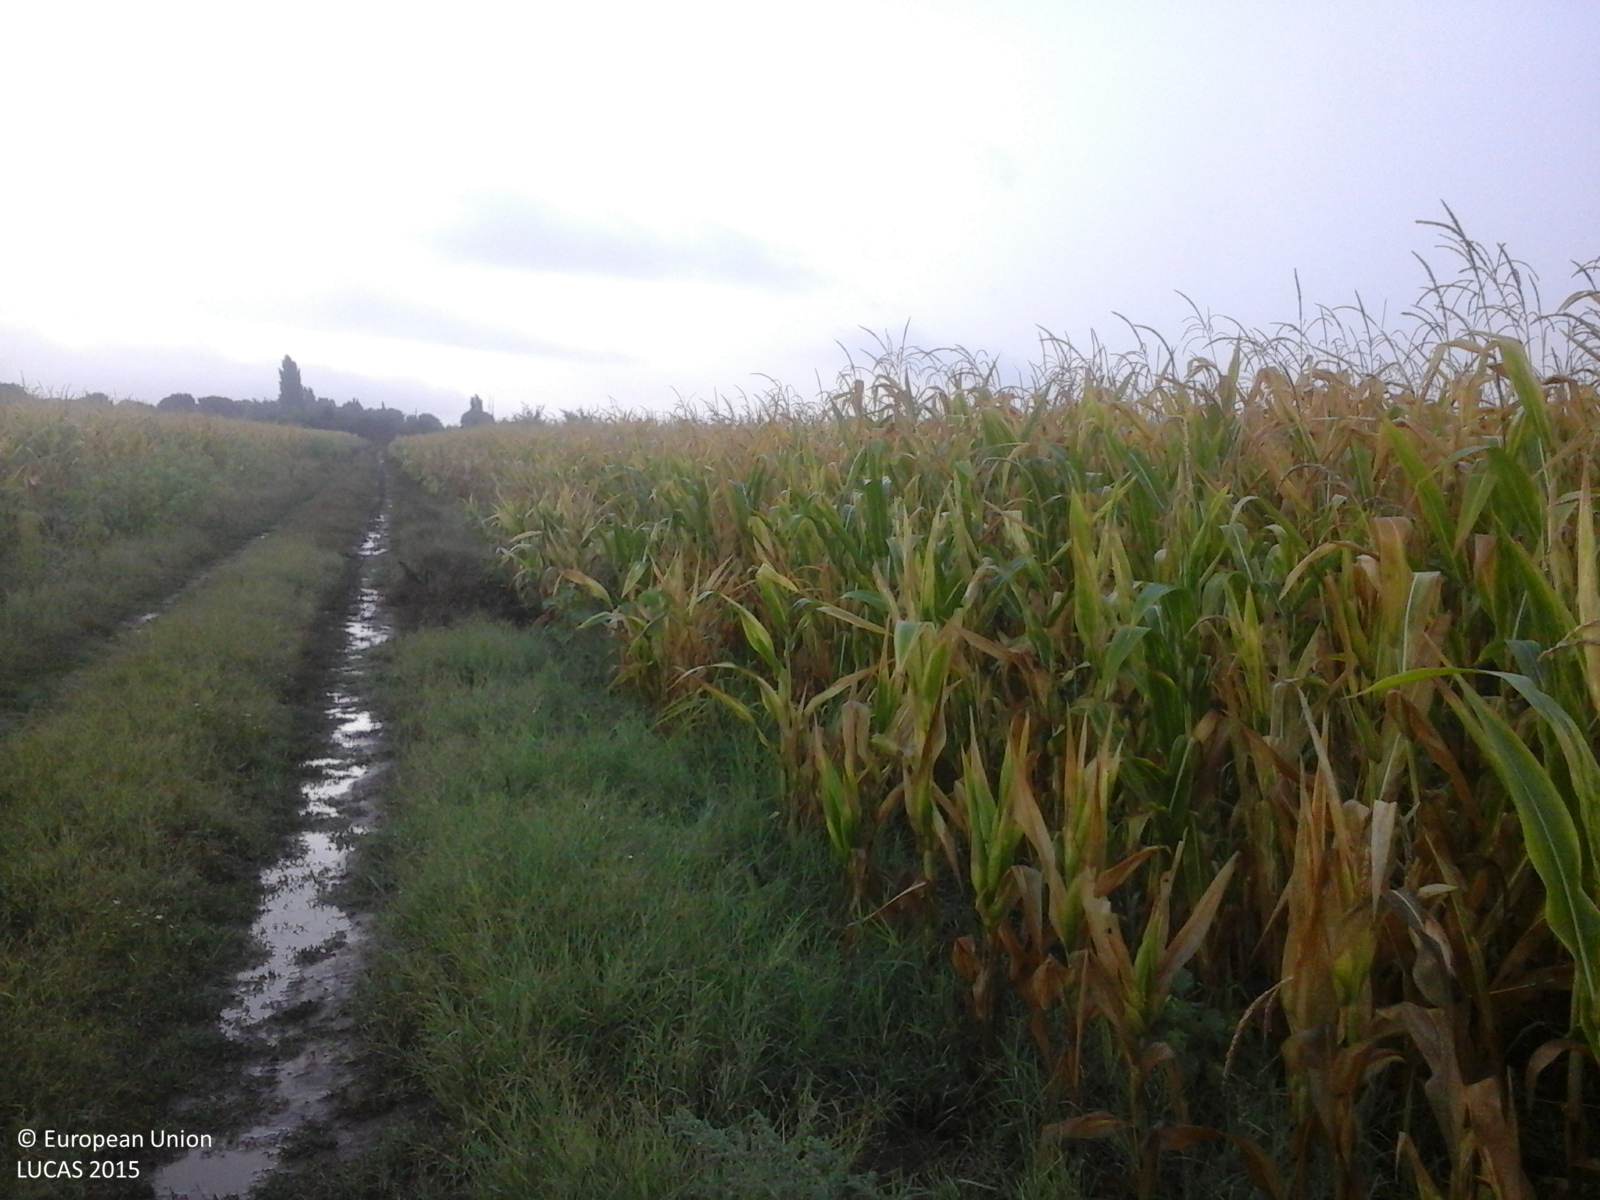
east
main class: Cropland
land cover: Maize
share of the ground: > 75 %
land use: Agriculture (excluding fallow land and kitchen gardens)
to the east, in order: Maize; Grass margins; Tracks; Grass margins; Maize
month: August
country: RO
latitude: 45.6264
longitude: 21.0976
